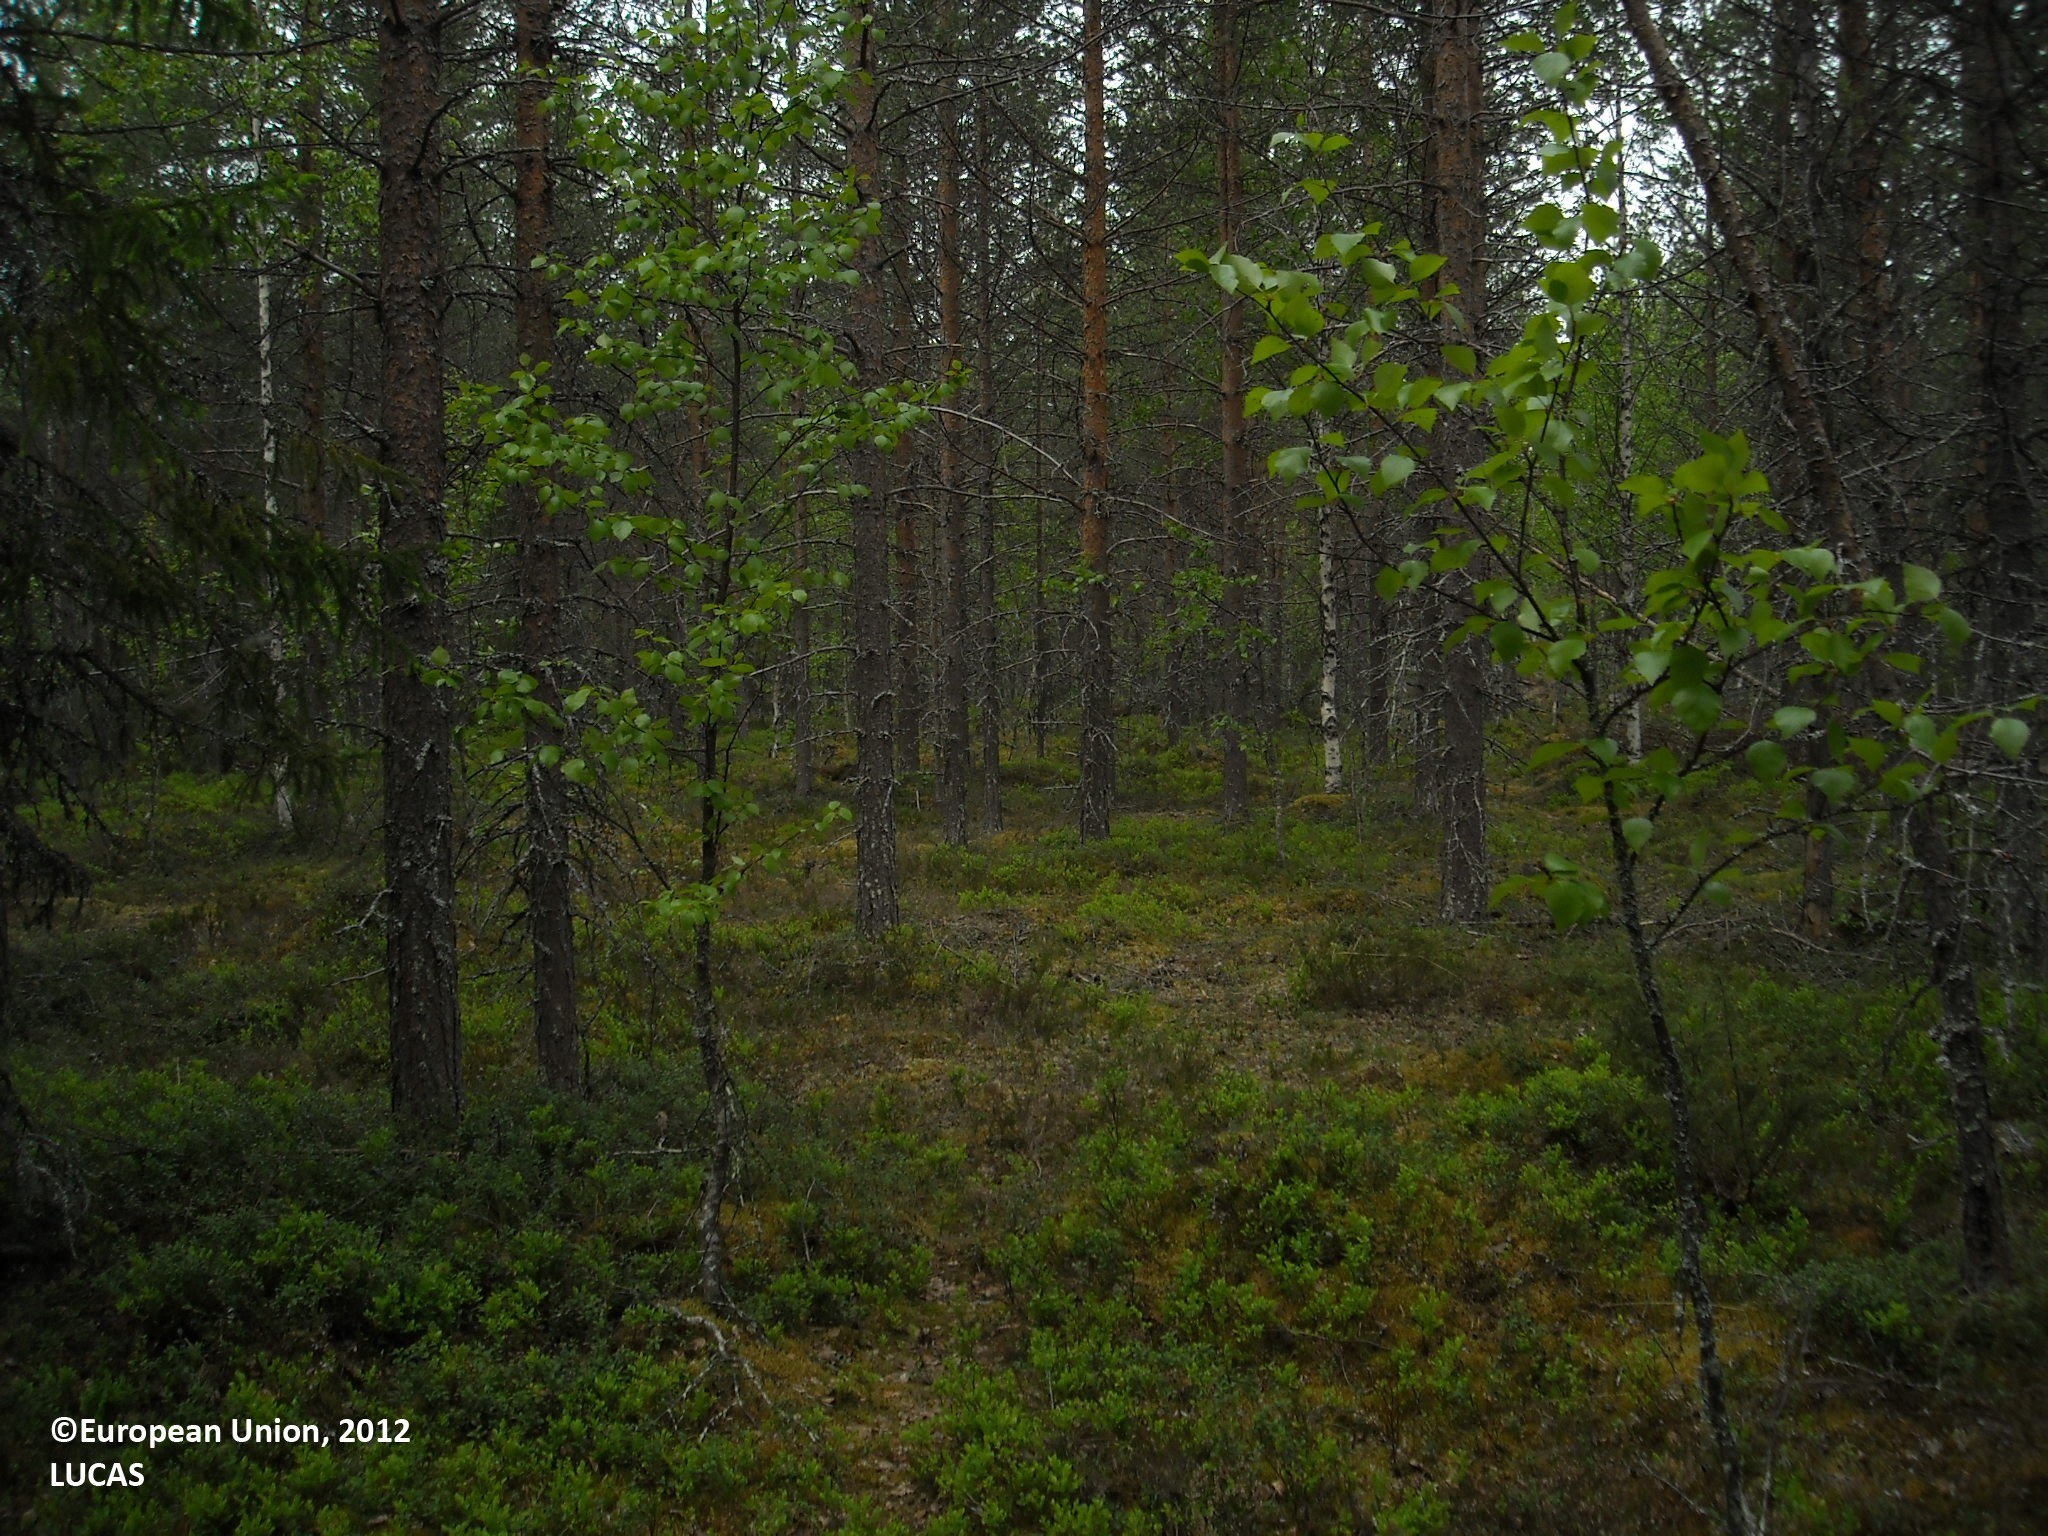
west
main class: Woodland
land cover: Pine dominated mixed woodland
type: boreal forest
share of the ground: > 75 %
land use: Forestry
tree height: > 5 m
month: June
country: FI
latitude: 65.5723
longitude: 28.0233
